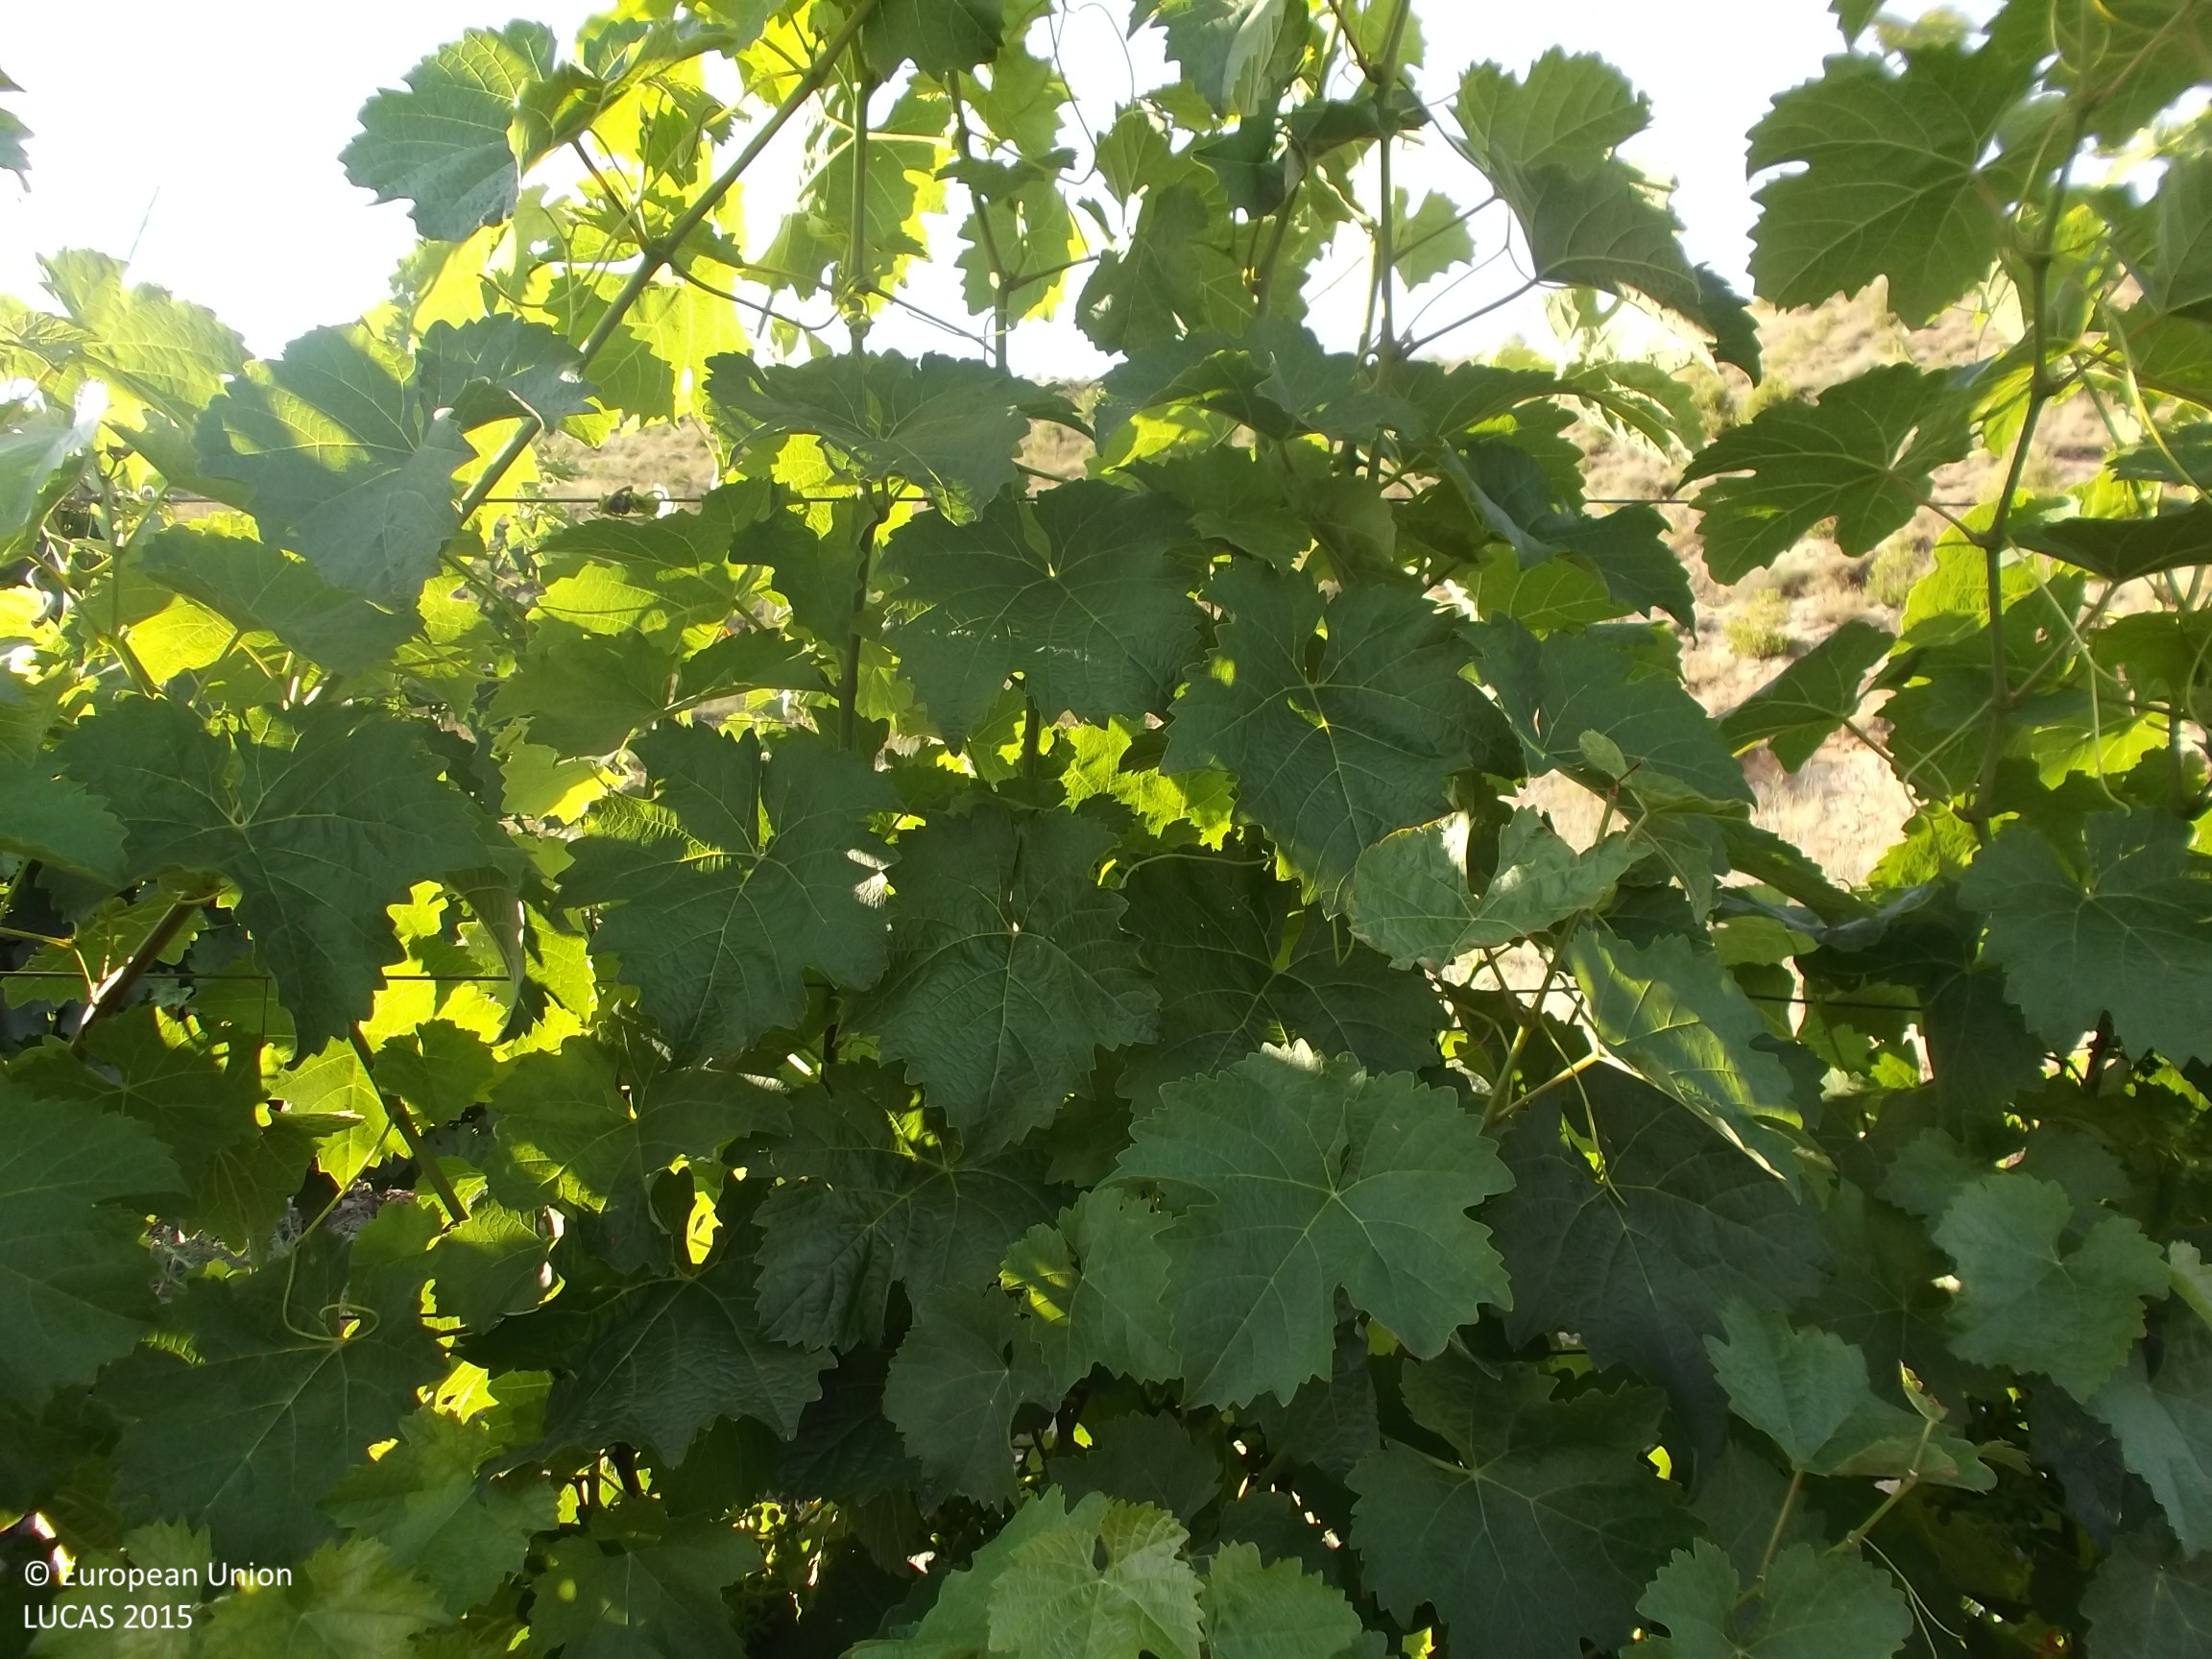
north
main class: Cropland
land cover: Vineyards
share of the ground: 10 - 25 %
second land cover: Spontaneously vegetated surfaces
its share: 25 - 50 %
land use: Agriculture (excluding fallow land and kitchen gardens)
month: June
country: ES
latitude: 42.3639
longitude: -2.0970
